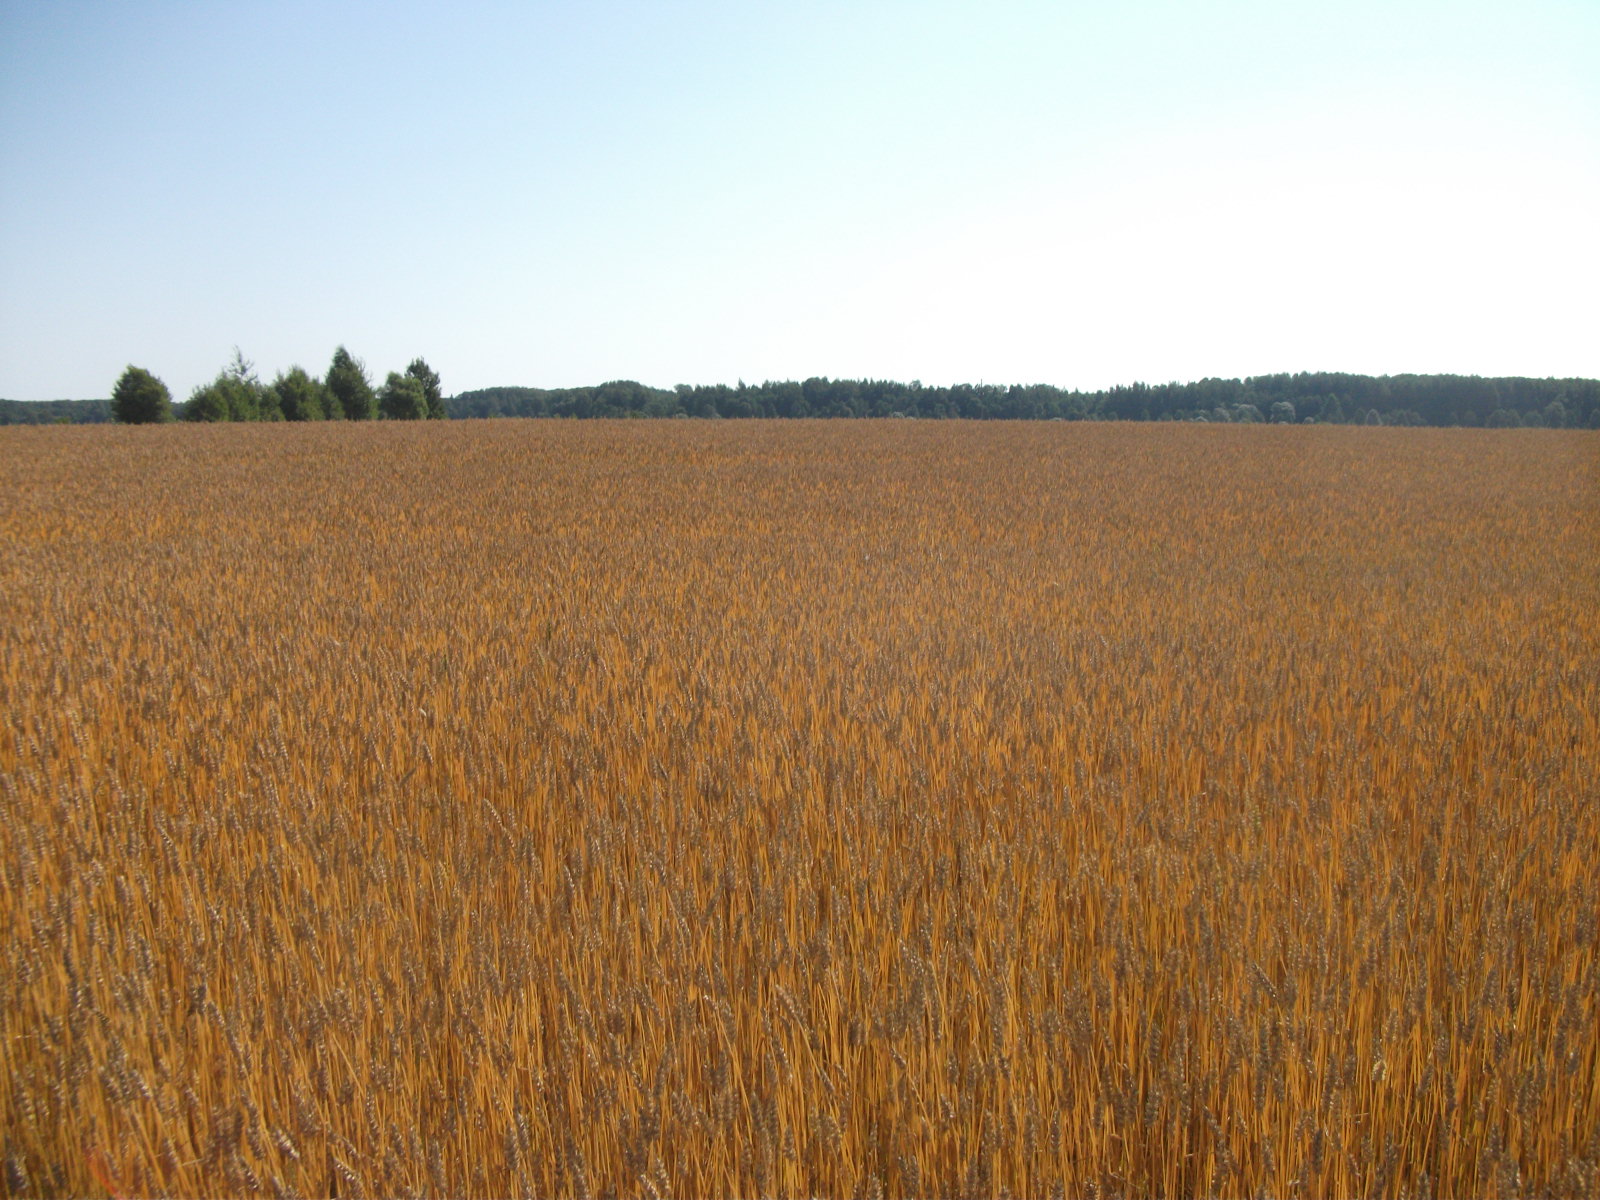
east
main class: Cropland
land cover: Common wheat
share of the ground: > 75 %
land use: Agriculture (excluding fallow land and kitchen gardens)
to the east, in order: Common wheat; Electric lines; Common wheat; Grass margins; Tracks; Grassland without tree/shrub cover; Common wheat
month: August
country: LV
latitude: 56.6974
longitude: 26.5943
